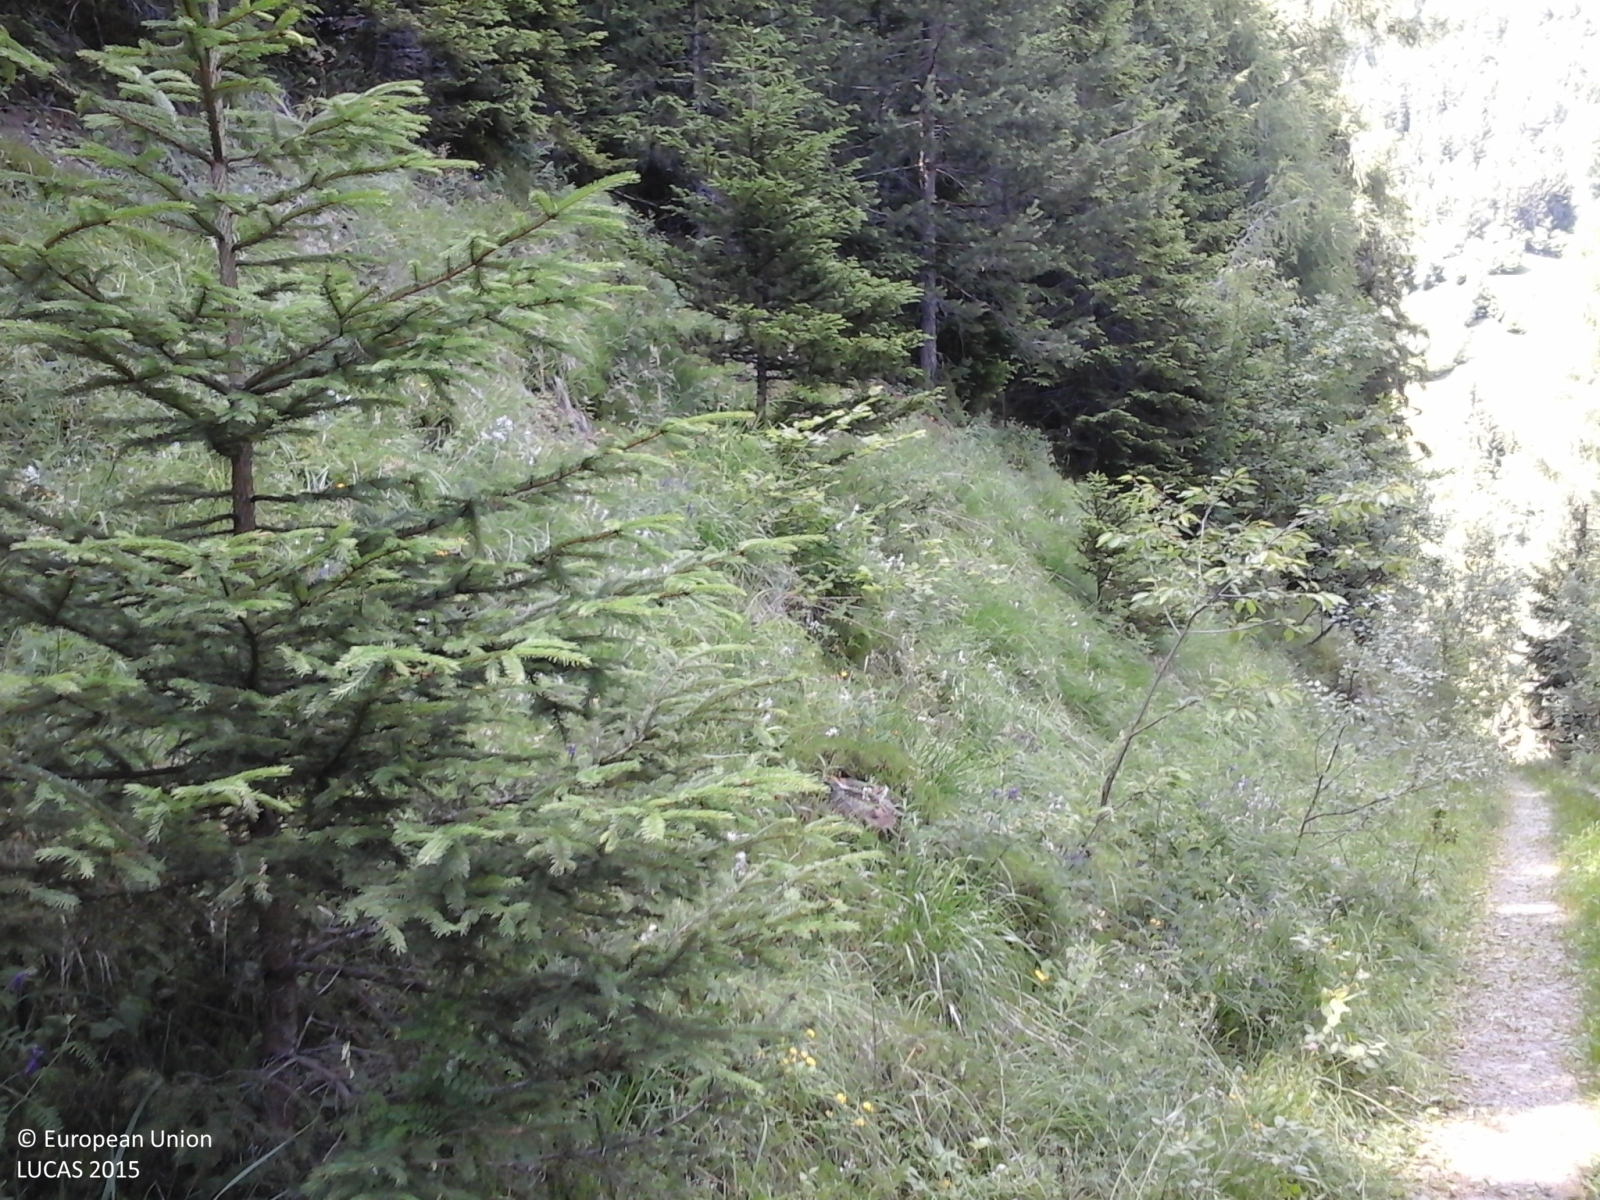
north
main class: Woodland
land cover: Spruce dominated coniferous woodland
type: alpine coniferous forest
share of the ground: > 75 %
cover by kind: coniferous forest trees 100 %
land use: Forestry
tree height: > 5 m
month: June
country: IT
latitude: 46.7534
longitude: 11.6085
